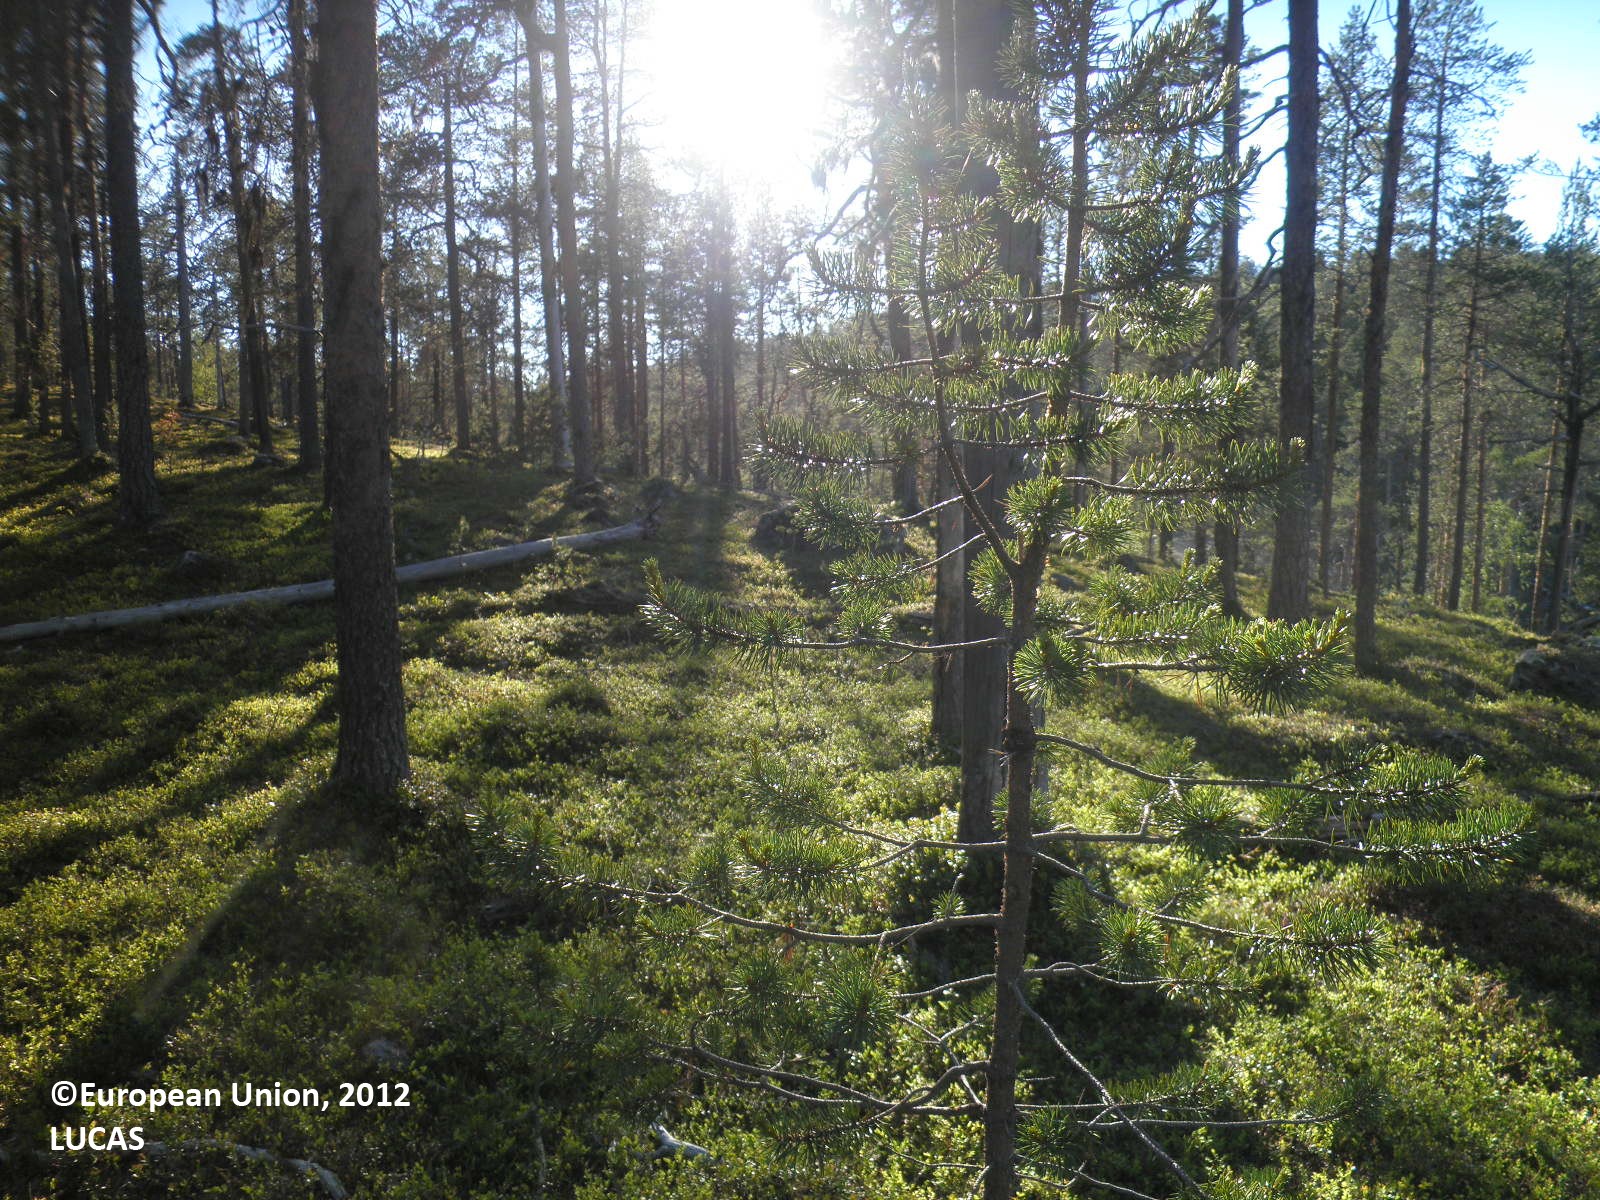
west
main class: Woodland
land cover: Pine dominated coniferous woodland
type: boreal forest
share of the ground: 50 - 75 %
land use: Forestry
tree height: > 5 m
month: July
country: FI
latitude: 68.7572
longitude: 27.2568
